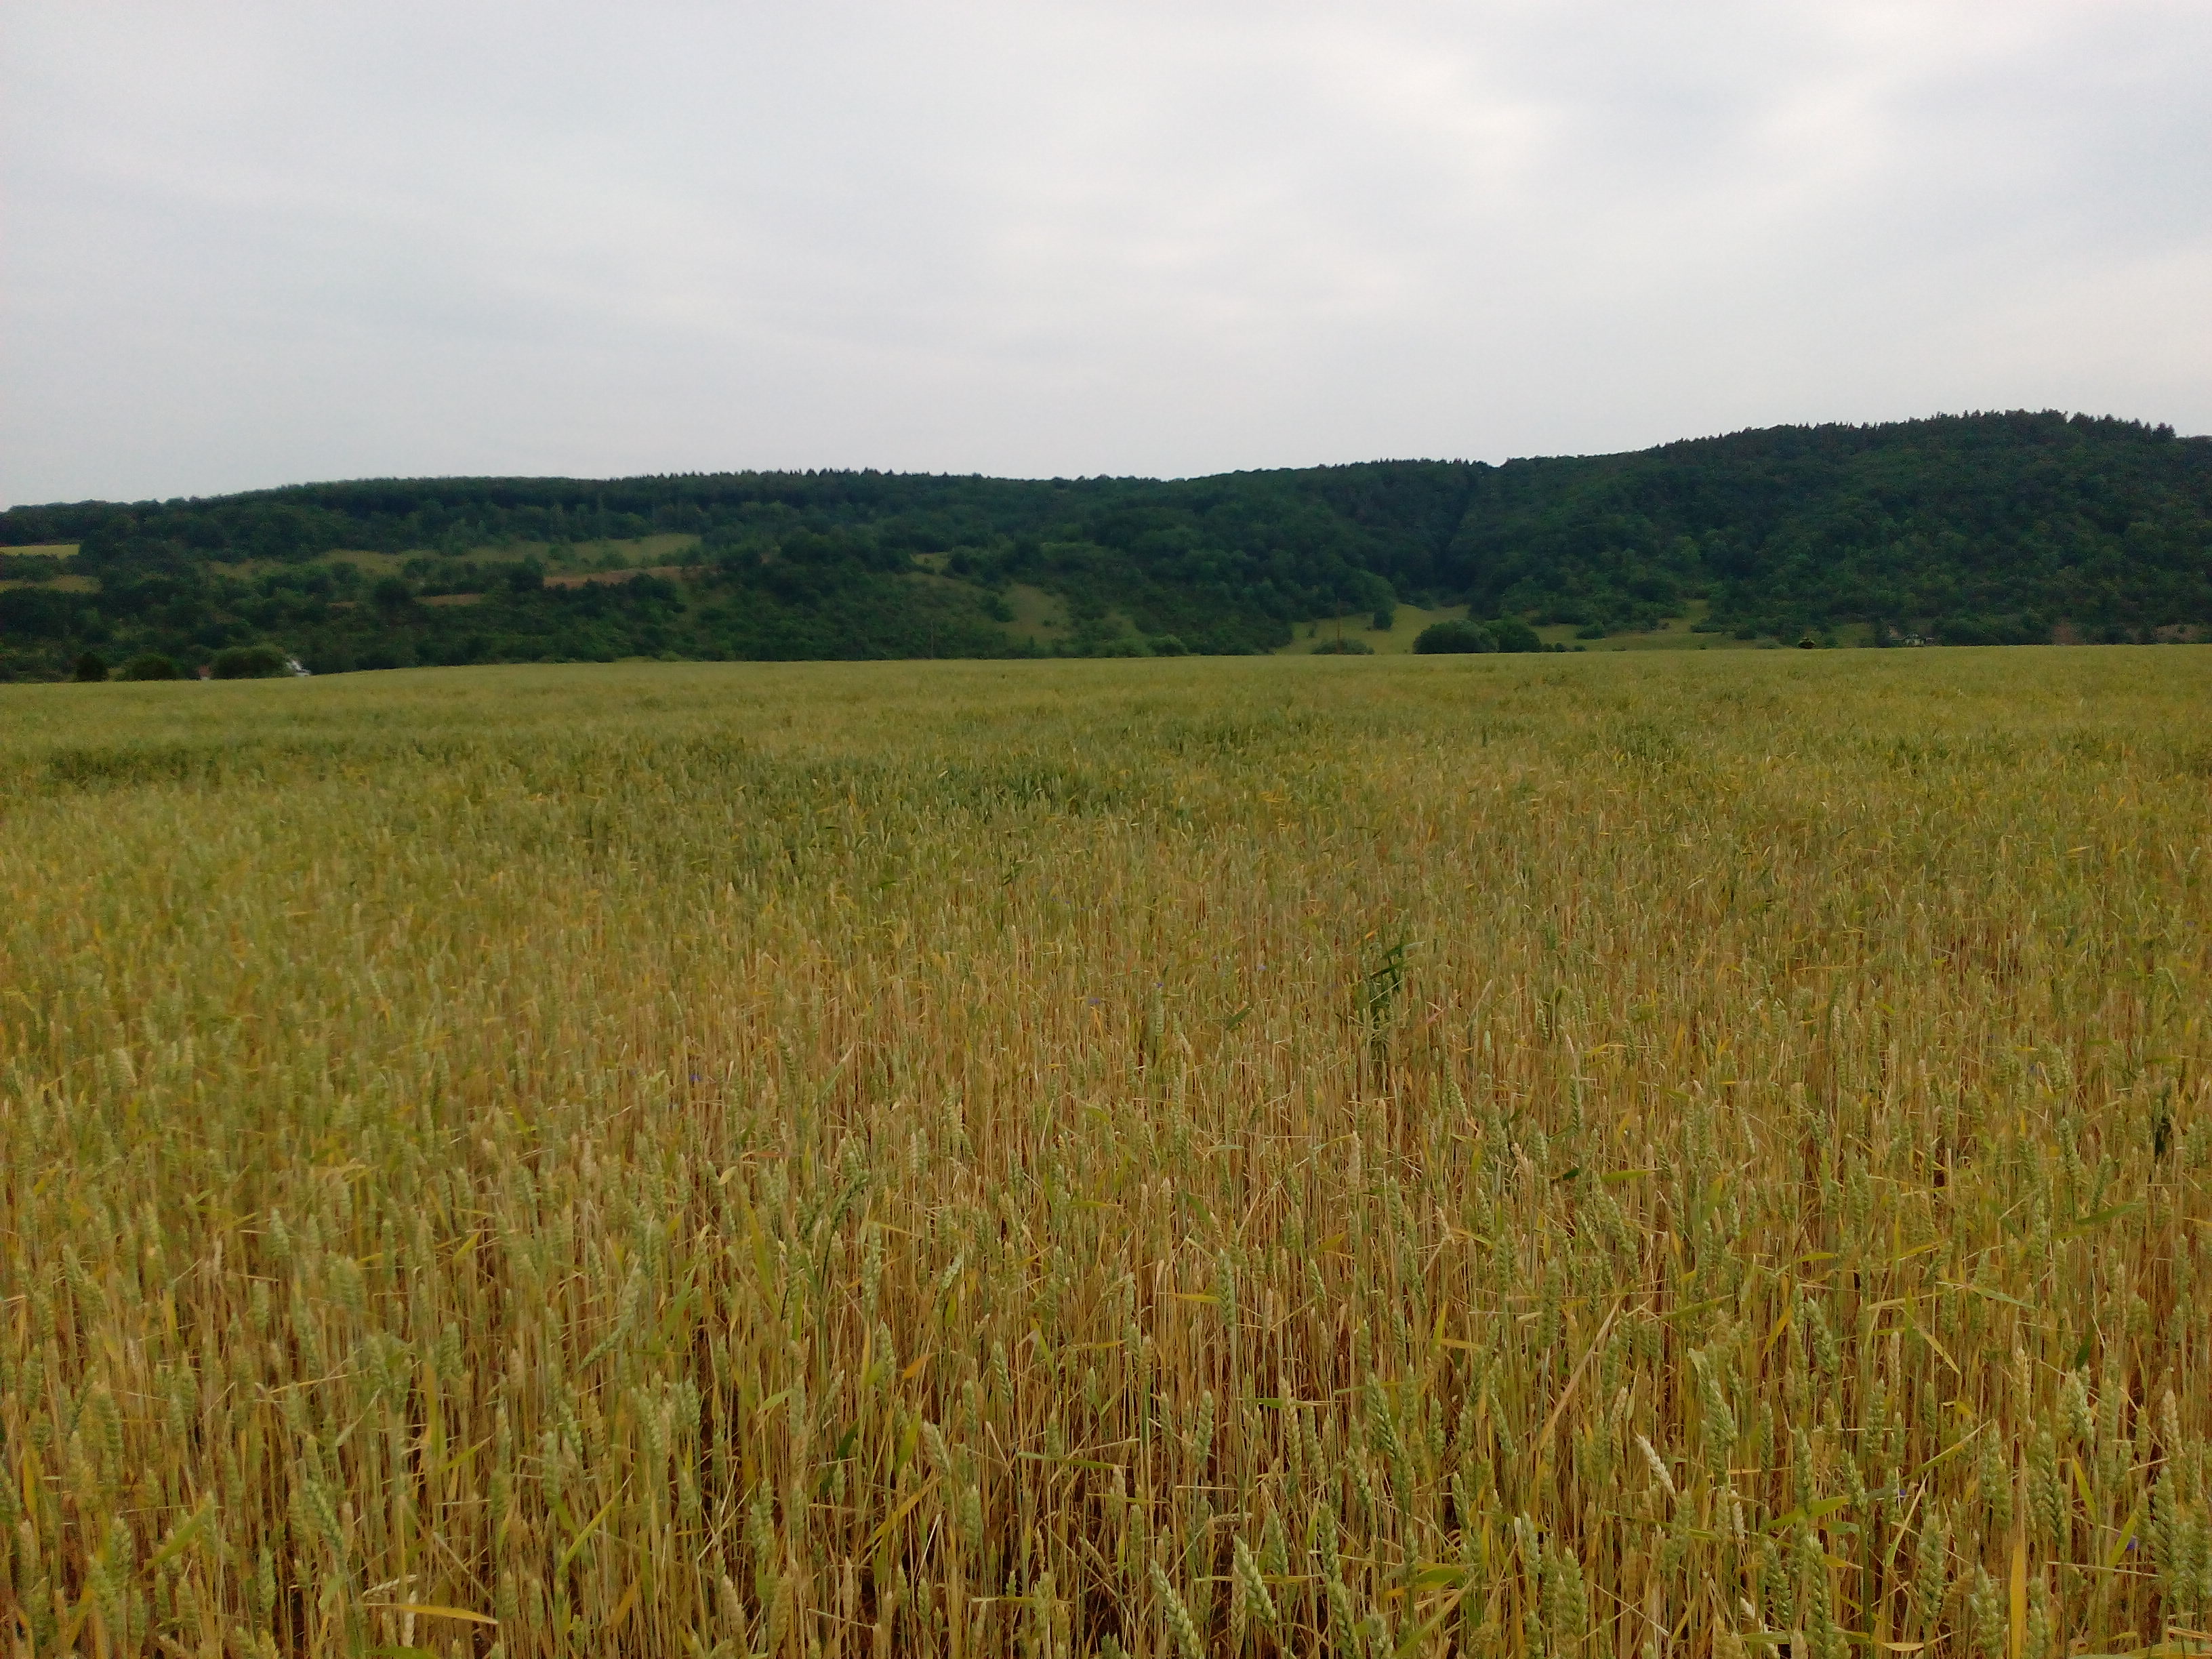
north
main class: Cropland
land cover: Common wheat
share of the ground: > 75 %
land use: Agriculture (excluding fallow land and kitchen gardens)
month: June
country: DE
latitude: 51.3489
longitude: 10.9617
